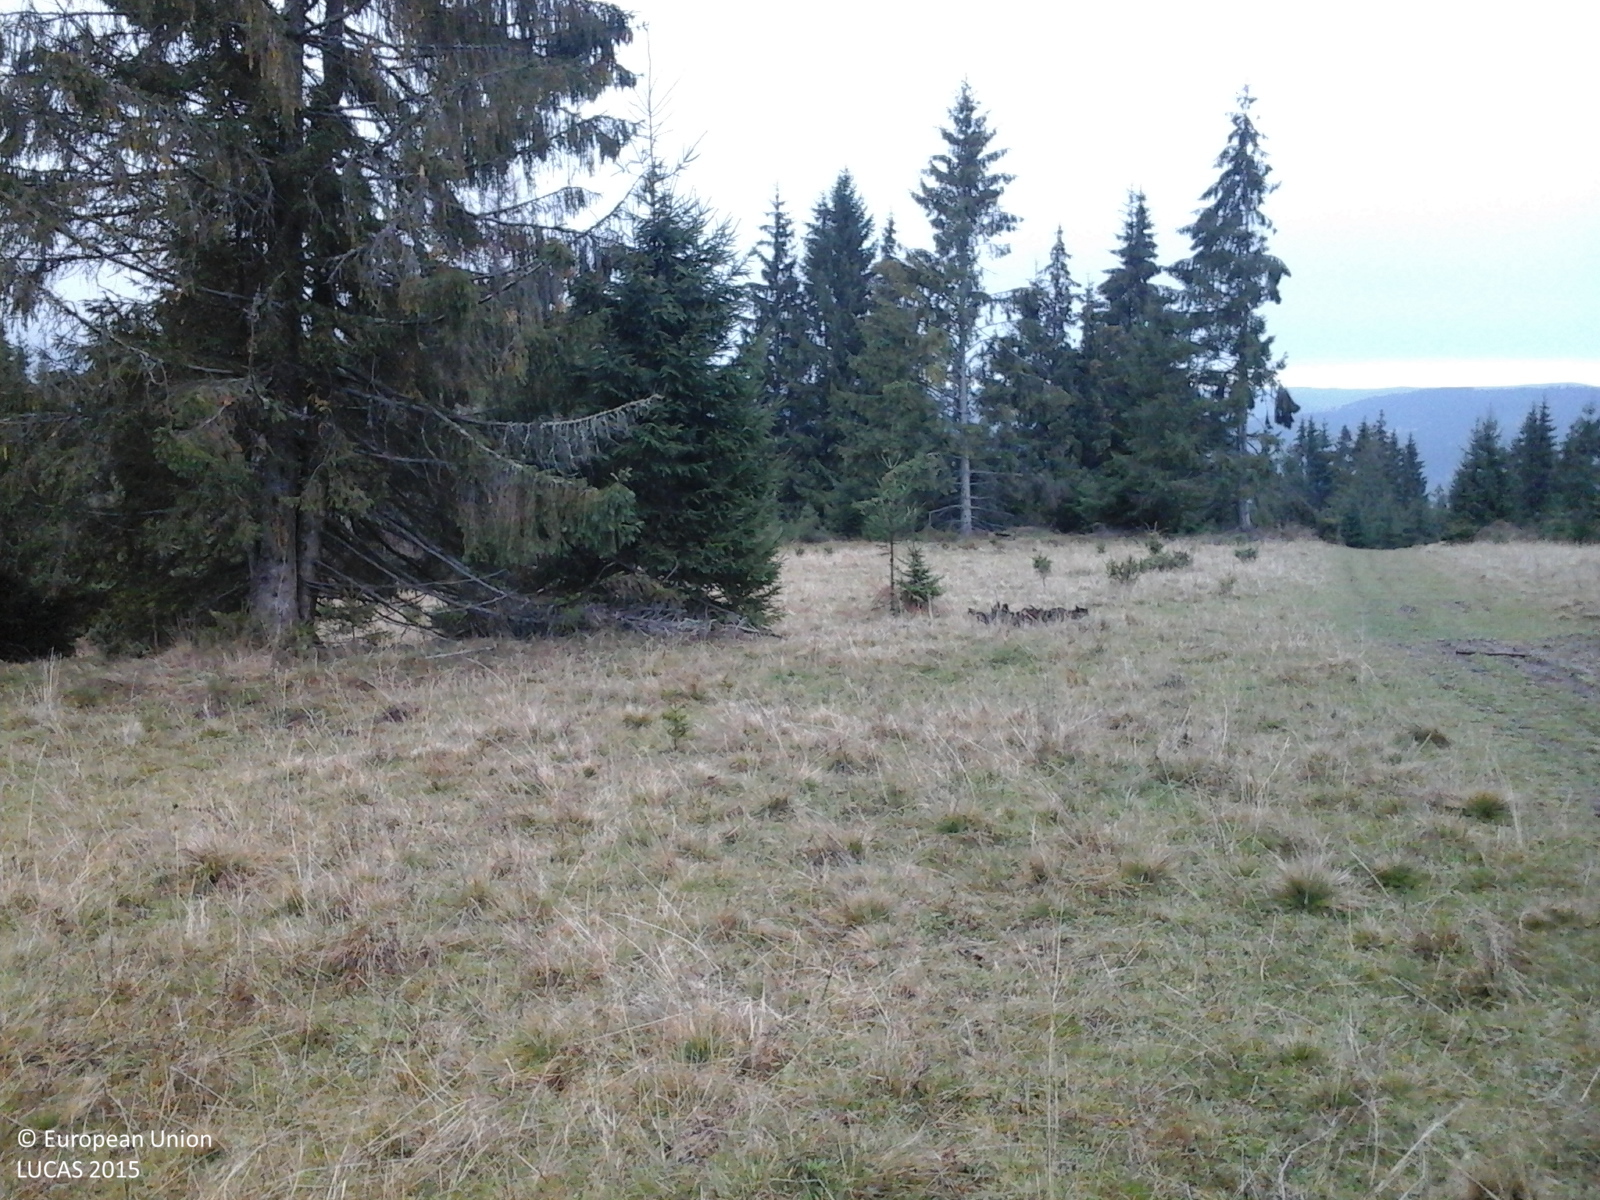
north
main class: Grassland
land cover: Grassland with sparse tree/shrub cover
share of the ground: > 75 %
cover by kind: herbaceous plants 95 %, coniferous forest trees 5 %
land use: Agriculture (excluding fallow land and kitchen gardens)
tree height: > 5 m
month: October
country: RO
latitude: 46.9345
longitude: 25.2510
